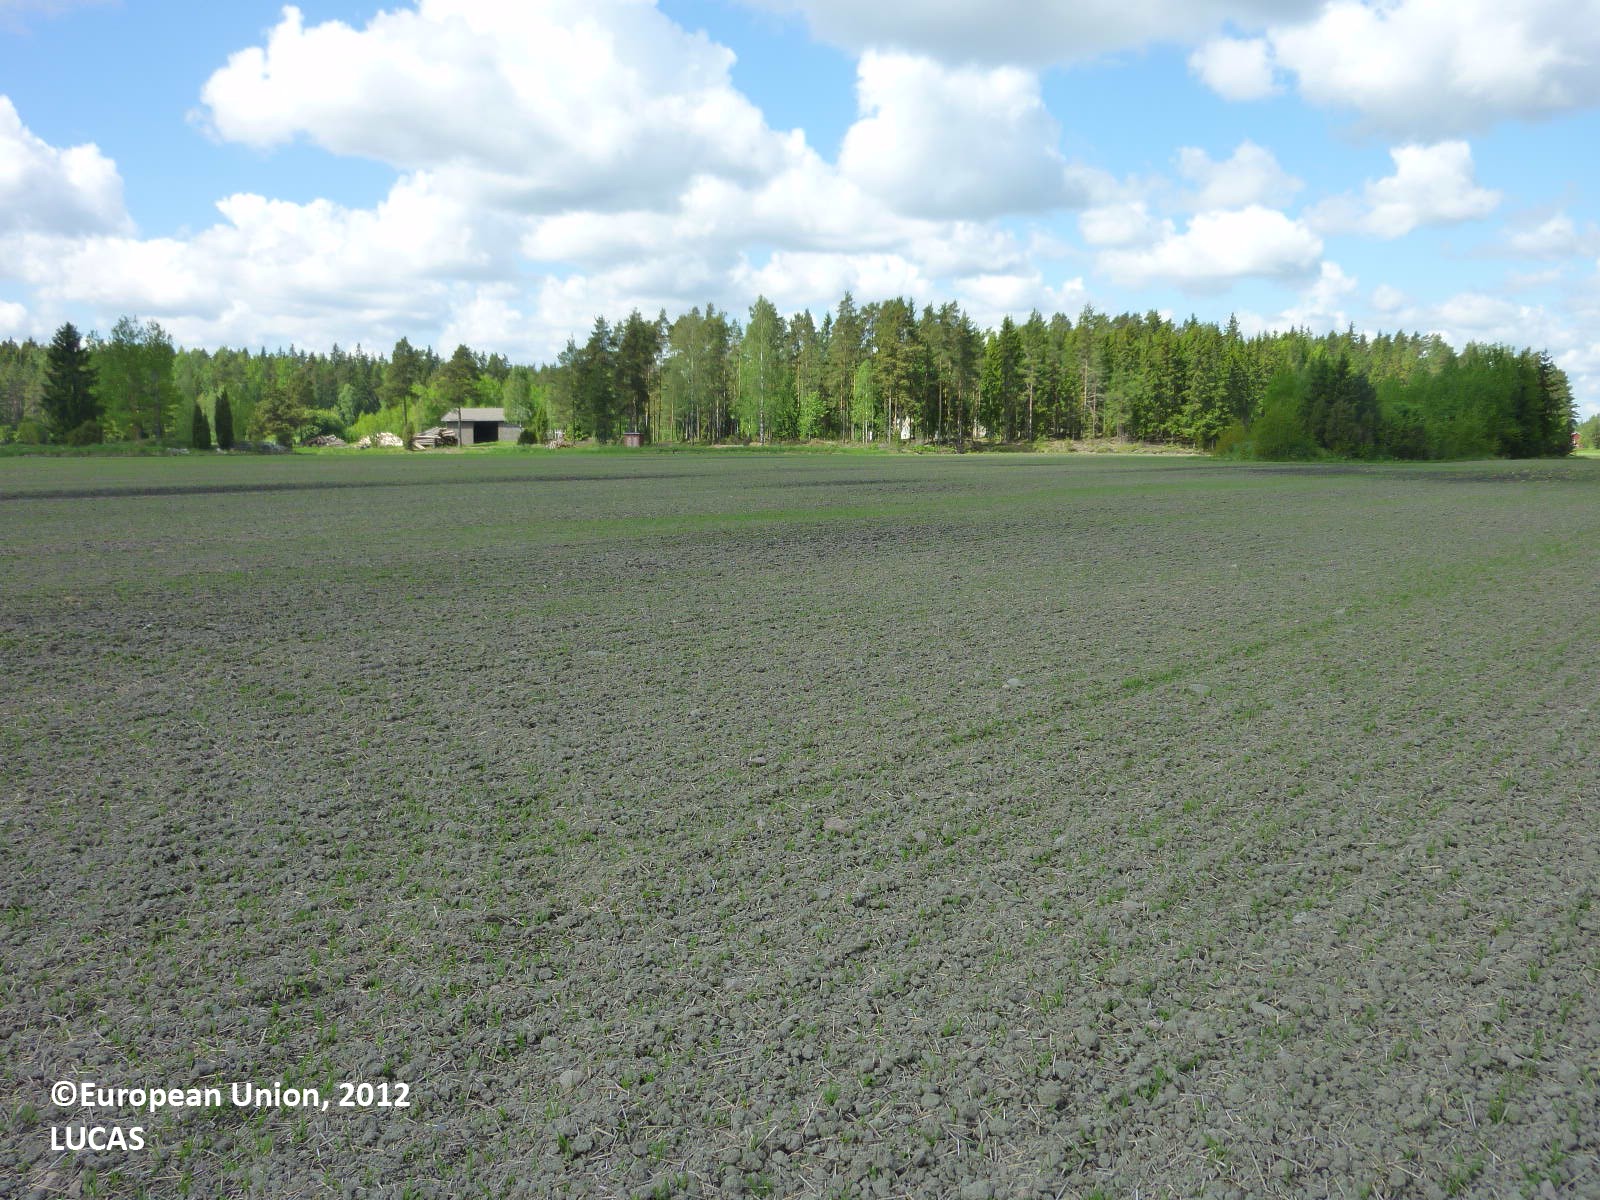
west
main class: Cropland
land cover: Barley
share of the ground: < 10 %
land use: Agriculture (excluding fallow land and kitchen gardens)
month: June
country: FI
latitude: 60.4950
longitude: 22.5397
